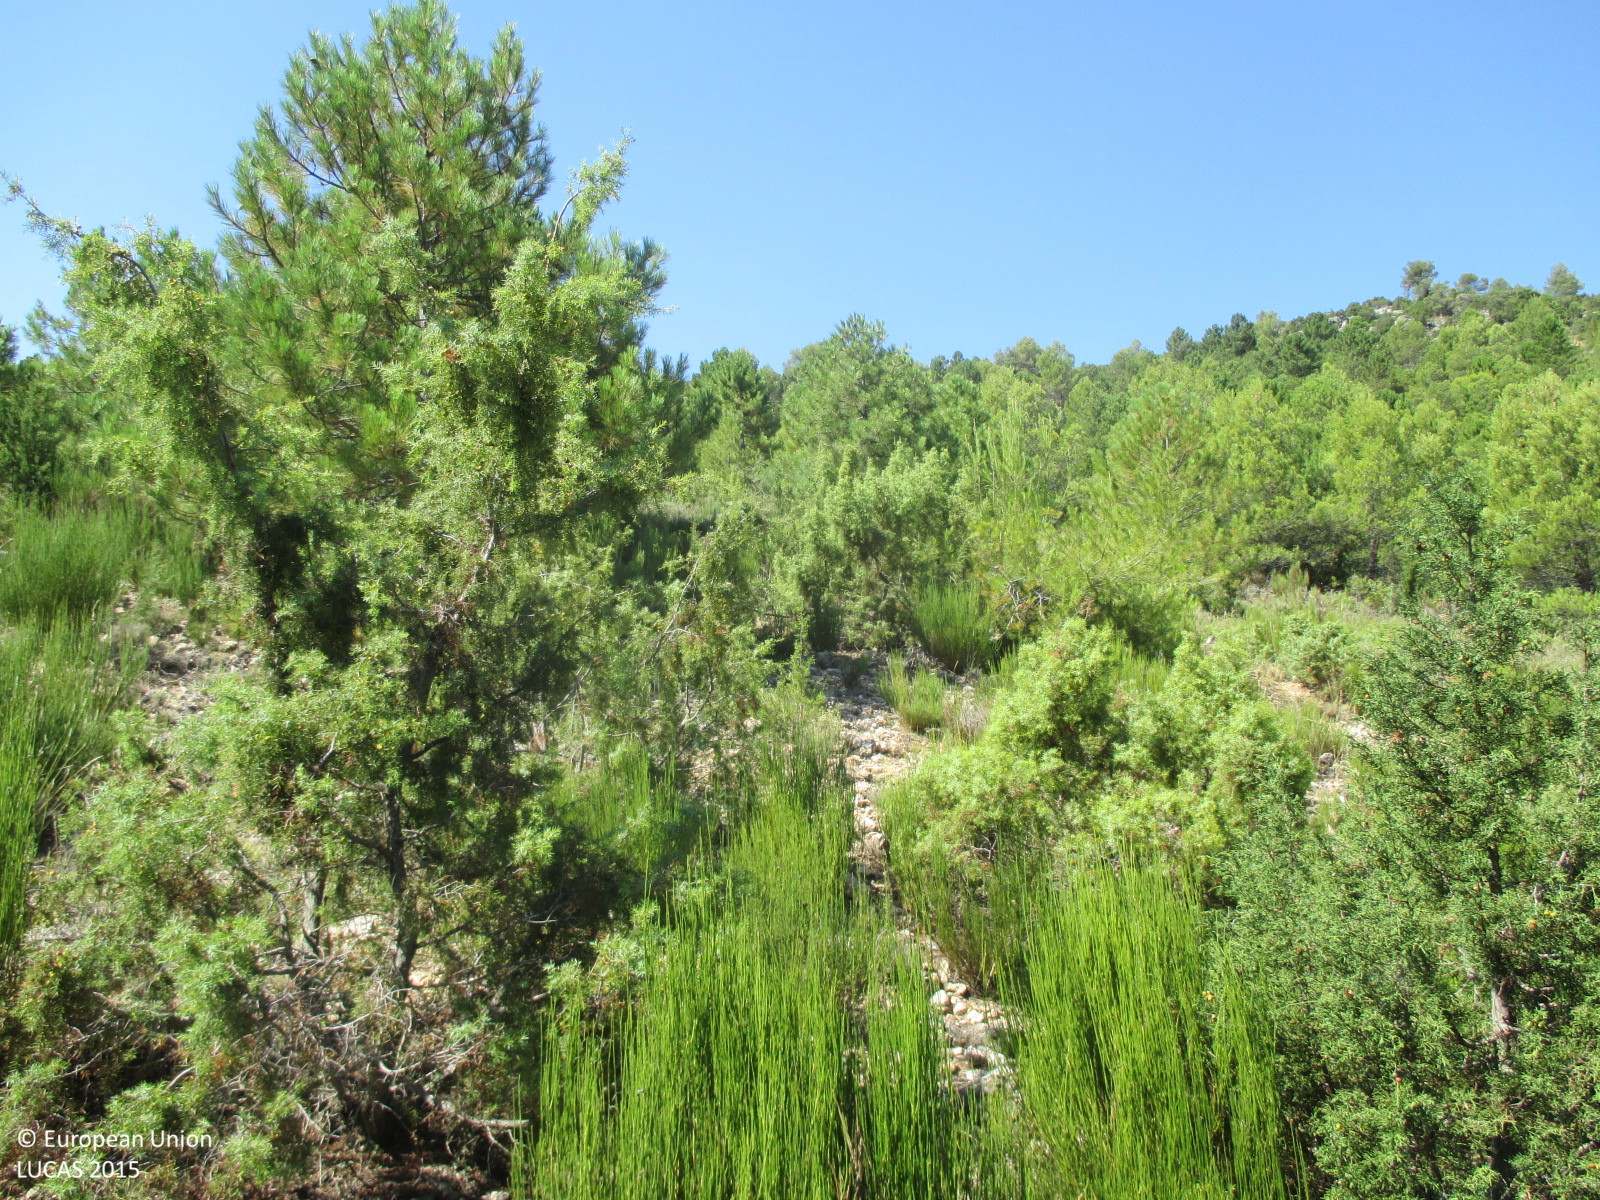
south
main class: Woodland
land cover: Pine dominated coniferous woodland
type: coniferous forest of the mediterranean region
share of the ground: 25 - 50 %
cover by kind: coniferous forest trees 40 %, shrubs 40 %, herbaceous plants 20 %
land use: Forestry
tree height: > 5 m
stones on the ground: < 10 %
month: July
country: ES
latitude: 38.2761
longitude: -2.3518
